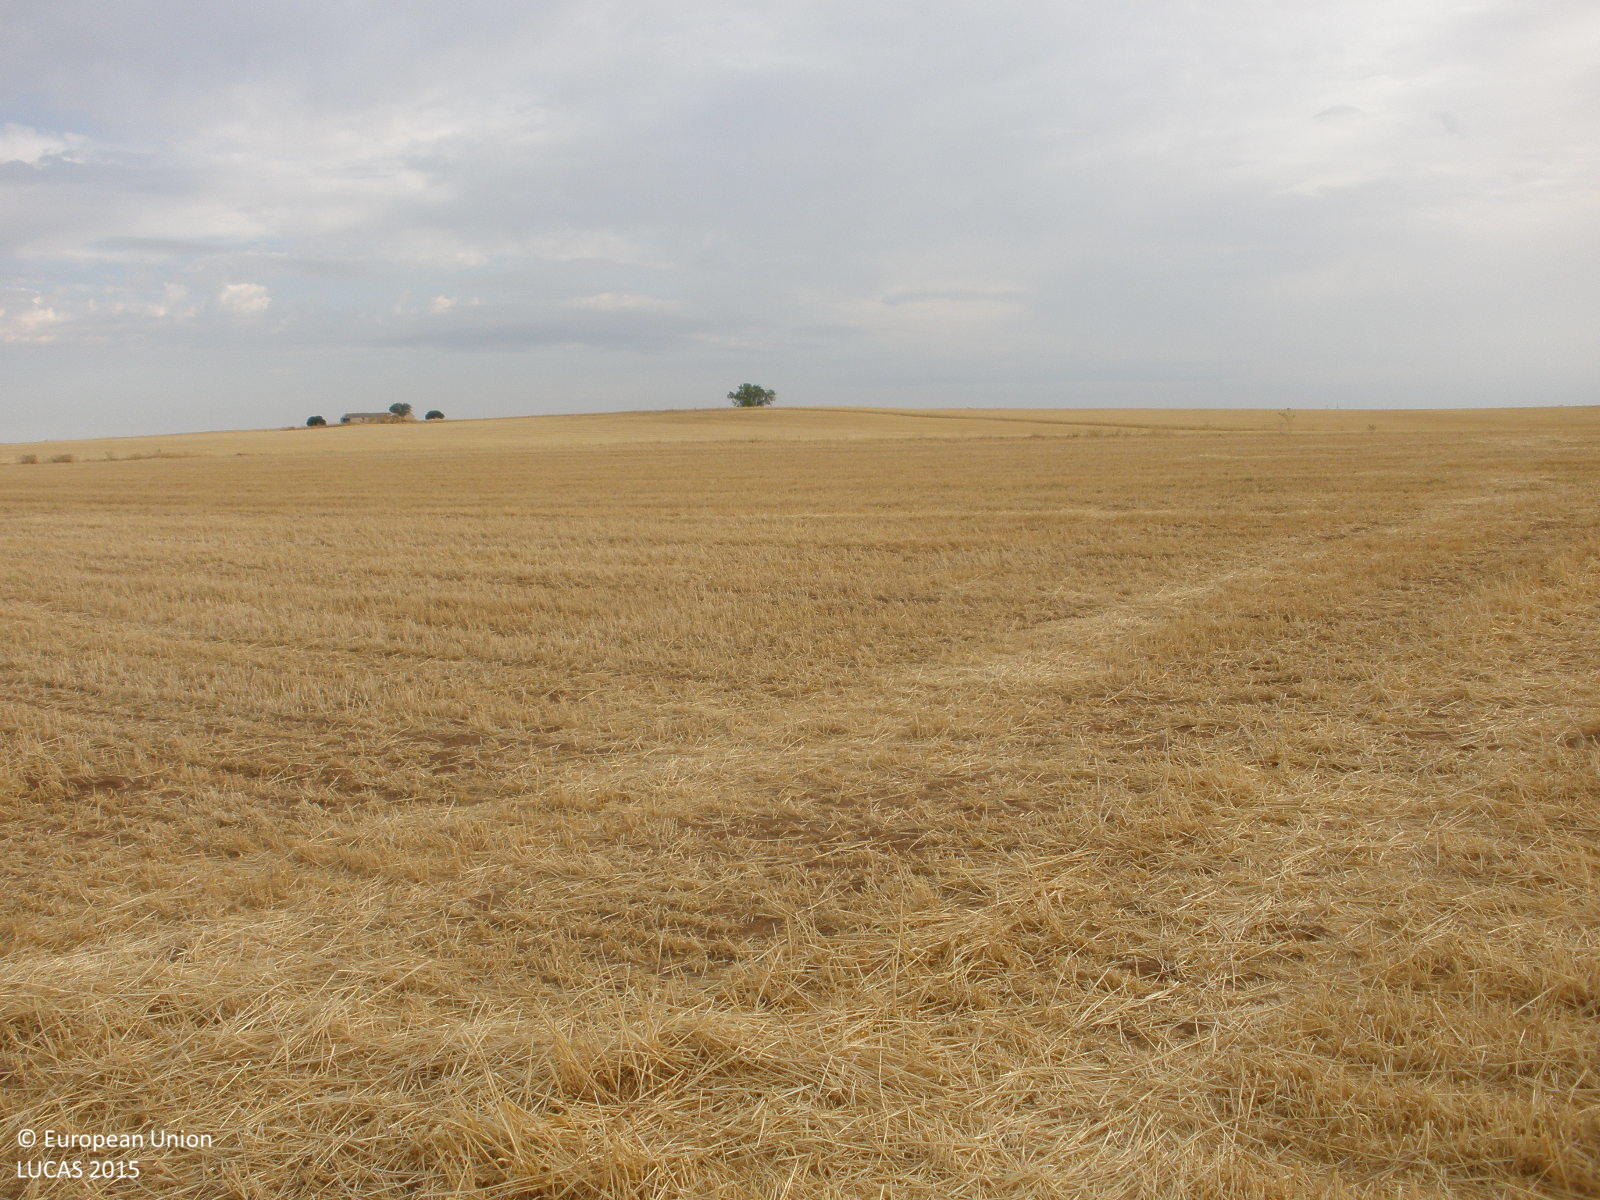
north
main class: Cropland
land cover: Barley
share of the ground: < 10 %
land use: Agriculture (excluding fallow land and kitchen gardens)
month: July
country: ES
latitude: 39.7996
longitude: -3.2801
